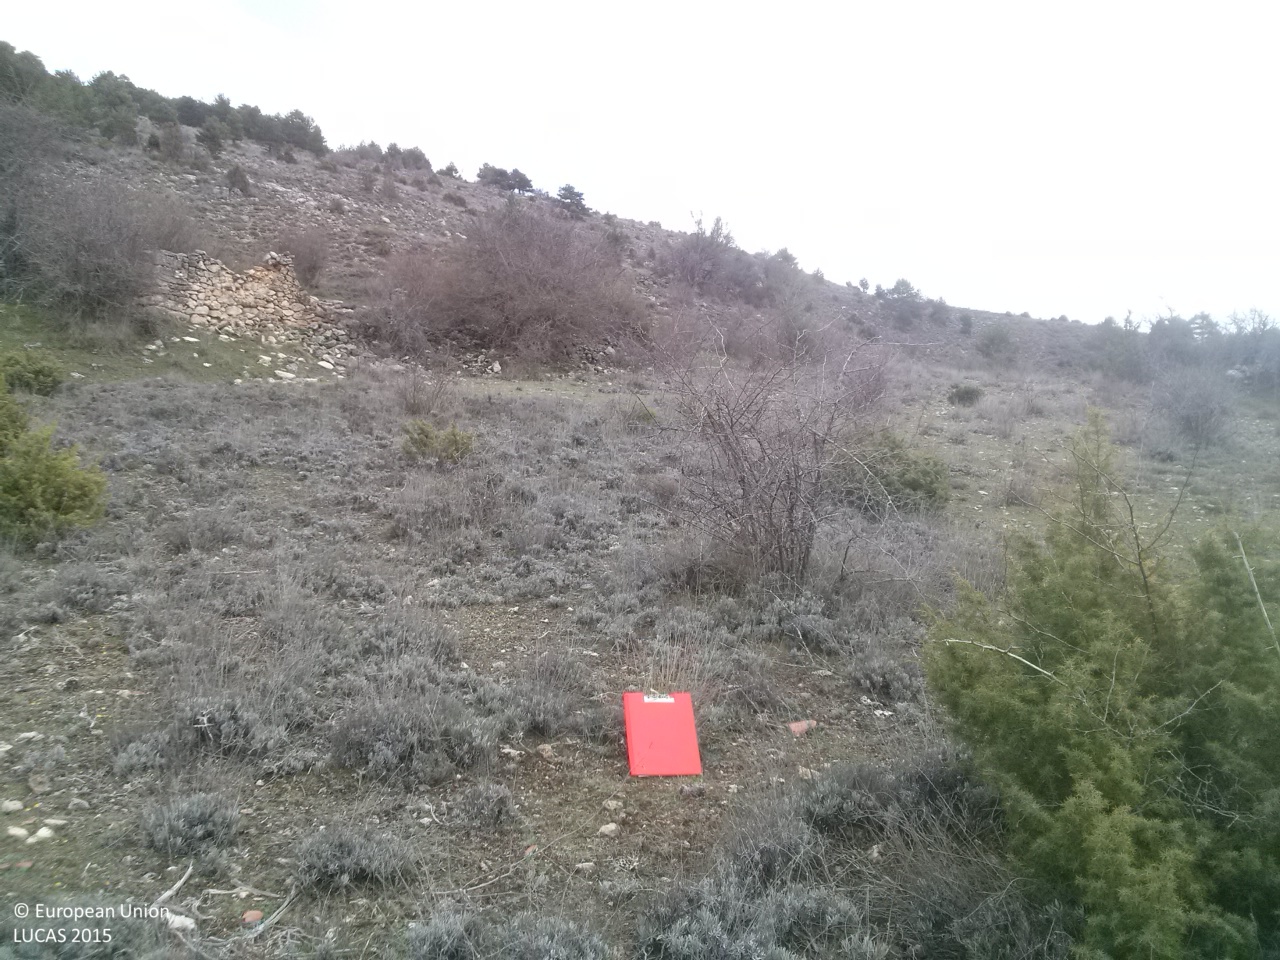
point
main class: Shrubland
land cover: Shrubland without tree cover
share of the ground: 25 - 50 %
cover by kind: shrubs 60 %, herbaceous plants 40 %
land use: Agriculture (excluding fallow land and kitchen gardens)
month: April
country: ES
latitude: 40.3681
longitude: -1.8523
